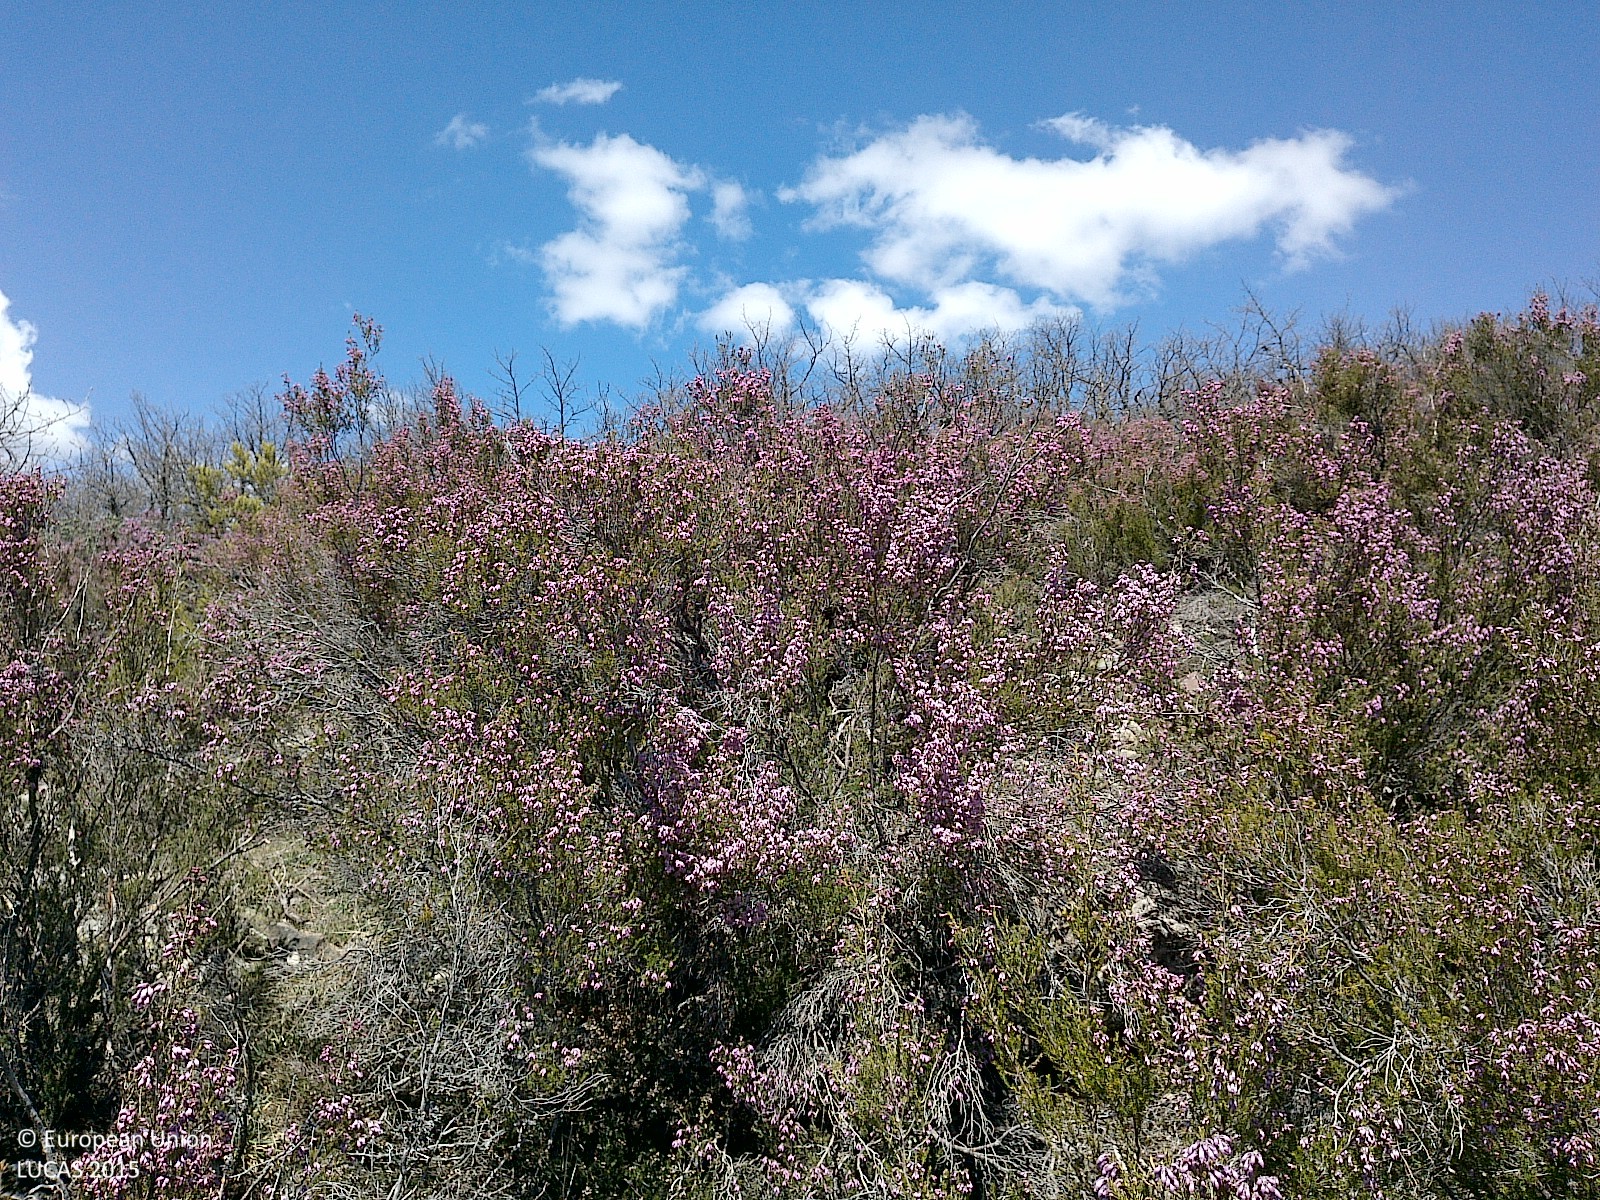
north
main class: Woodland
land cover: Broadleaved woodland
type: thermophilous deciduous forest
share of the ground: 10 - 25 %
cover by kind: shrubs 65 %, broadleaved forest trees 20 %, consolidated bare surface 10 %, herbaceous plants 5 %
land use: Semi-natural and natural areas not in use
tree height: < 5 m
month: April
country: ES
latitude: 42.1444
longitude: -3.2532
